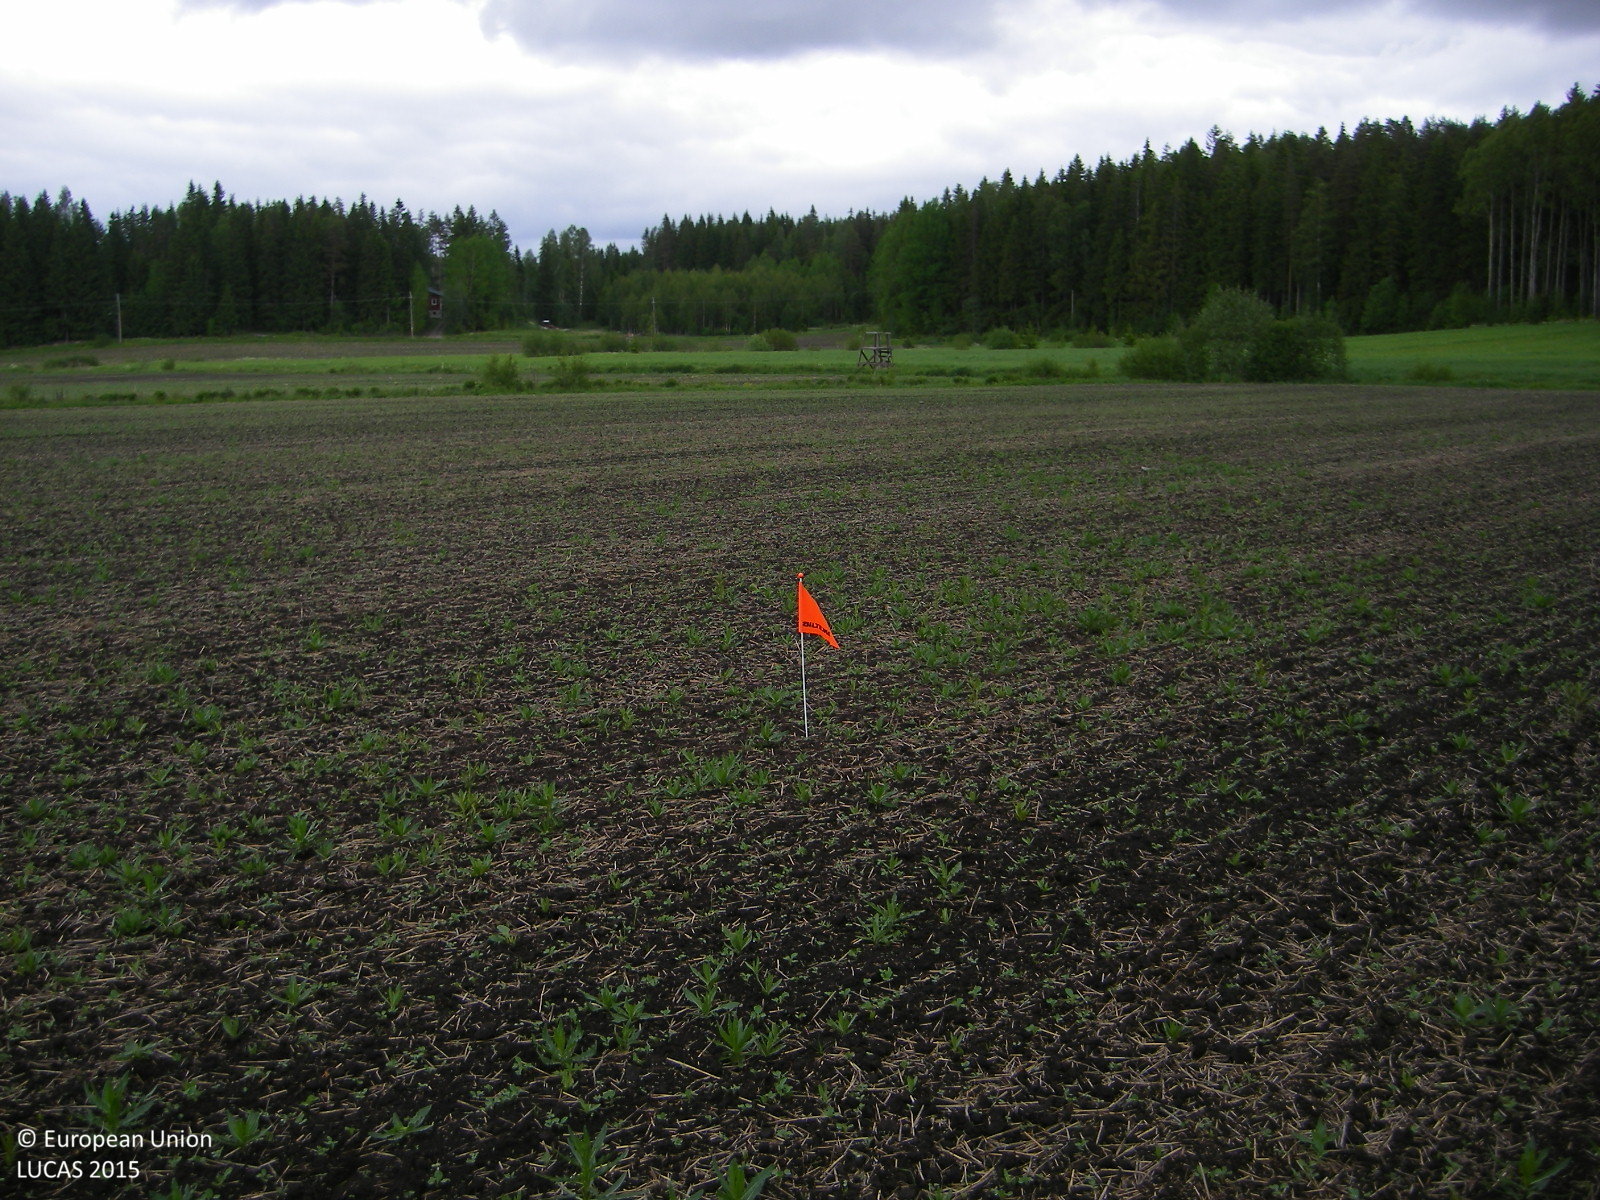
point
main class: Cropland
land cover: Other root crops
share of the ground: 10 - 25 %
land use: Agriculture (excluding fallow land and kitchen gardens)
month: June
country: FI
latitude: 60.2621
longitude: 24.2174
